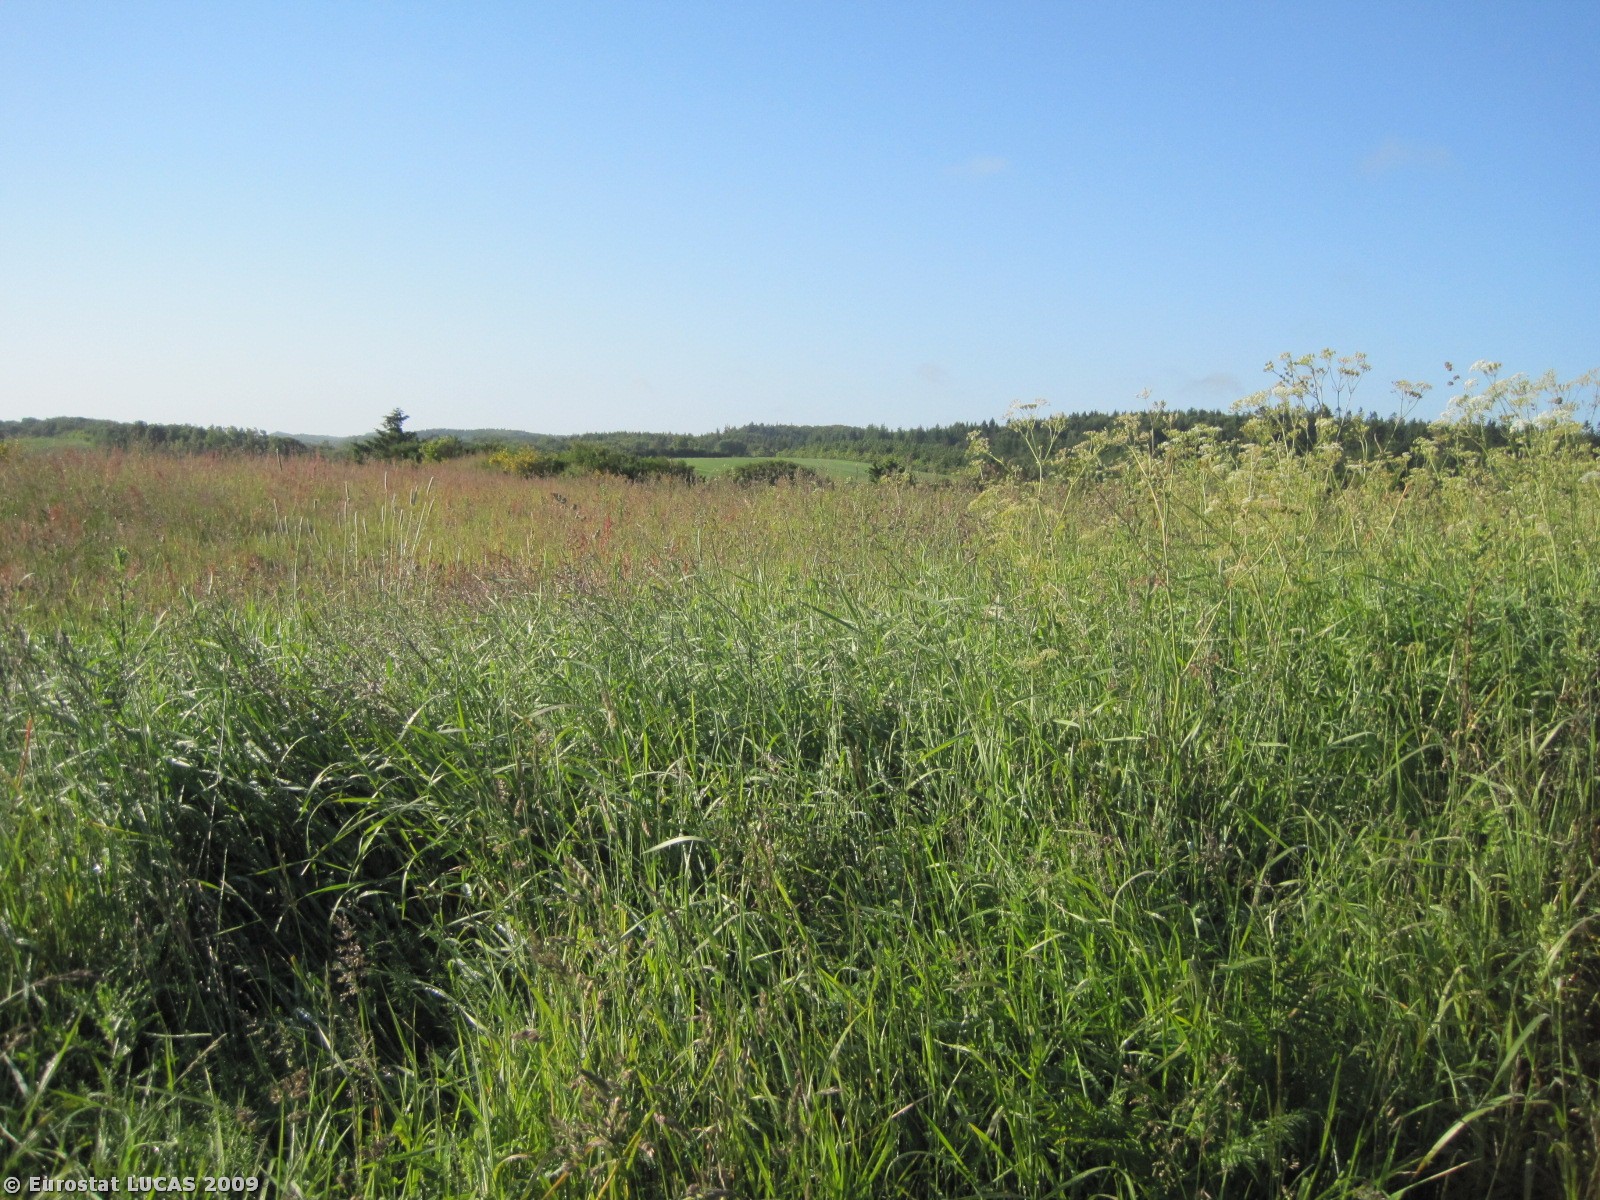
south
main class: Grassland
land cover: Grassland without tree/shrub cover
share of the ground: > 75 %
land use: Unused
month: June
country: DK
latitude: 57.2302
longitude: 10.2481
